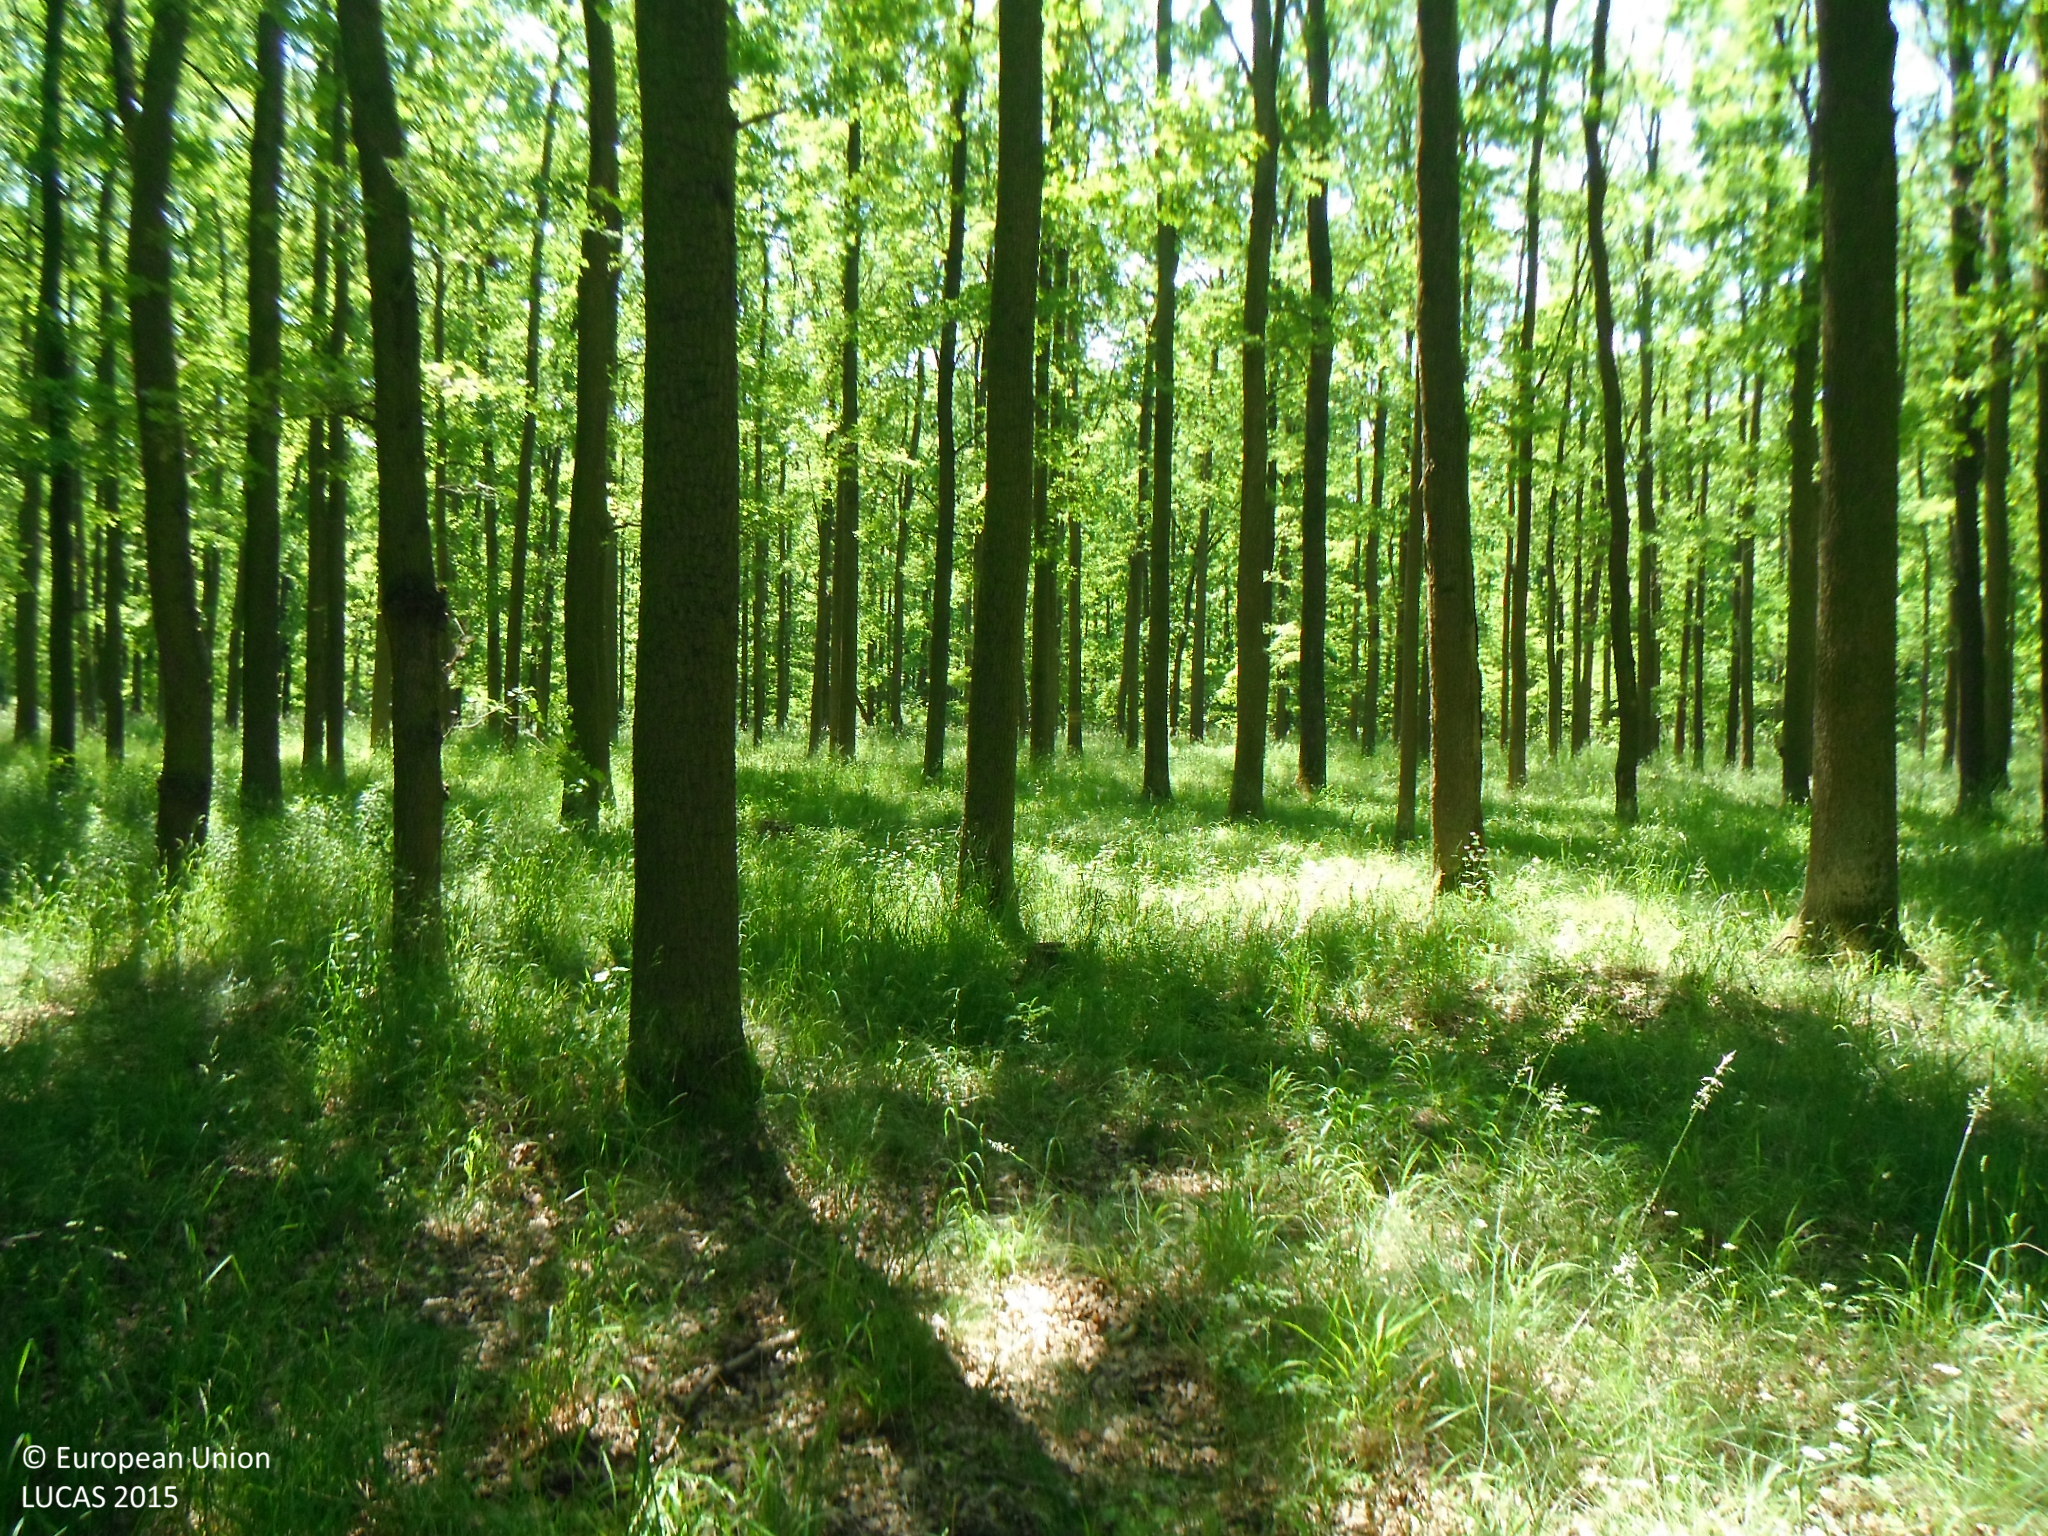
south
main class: Woodland
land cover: Broadleaved woodland
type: mesophytic deciduous forest
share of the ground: > 75 %
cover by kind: broadleaved forest trees 90 %, shrubs 5 %, herbaceous plants 5 %
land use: Forestry
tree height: > 5 m
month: June
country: SK
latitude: 48.7551
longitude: 17.0684
